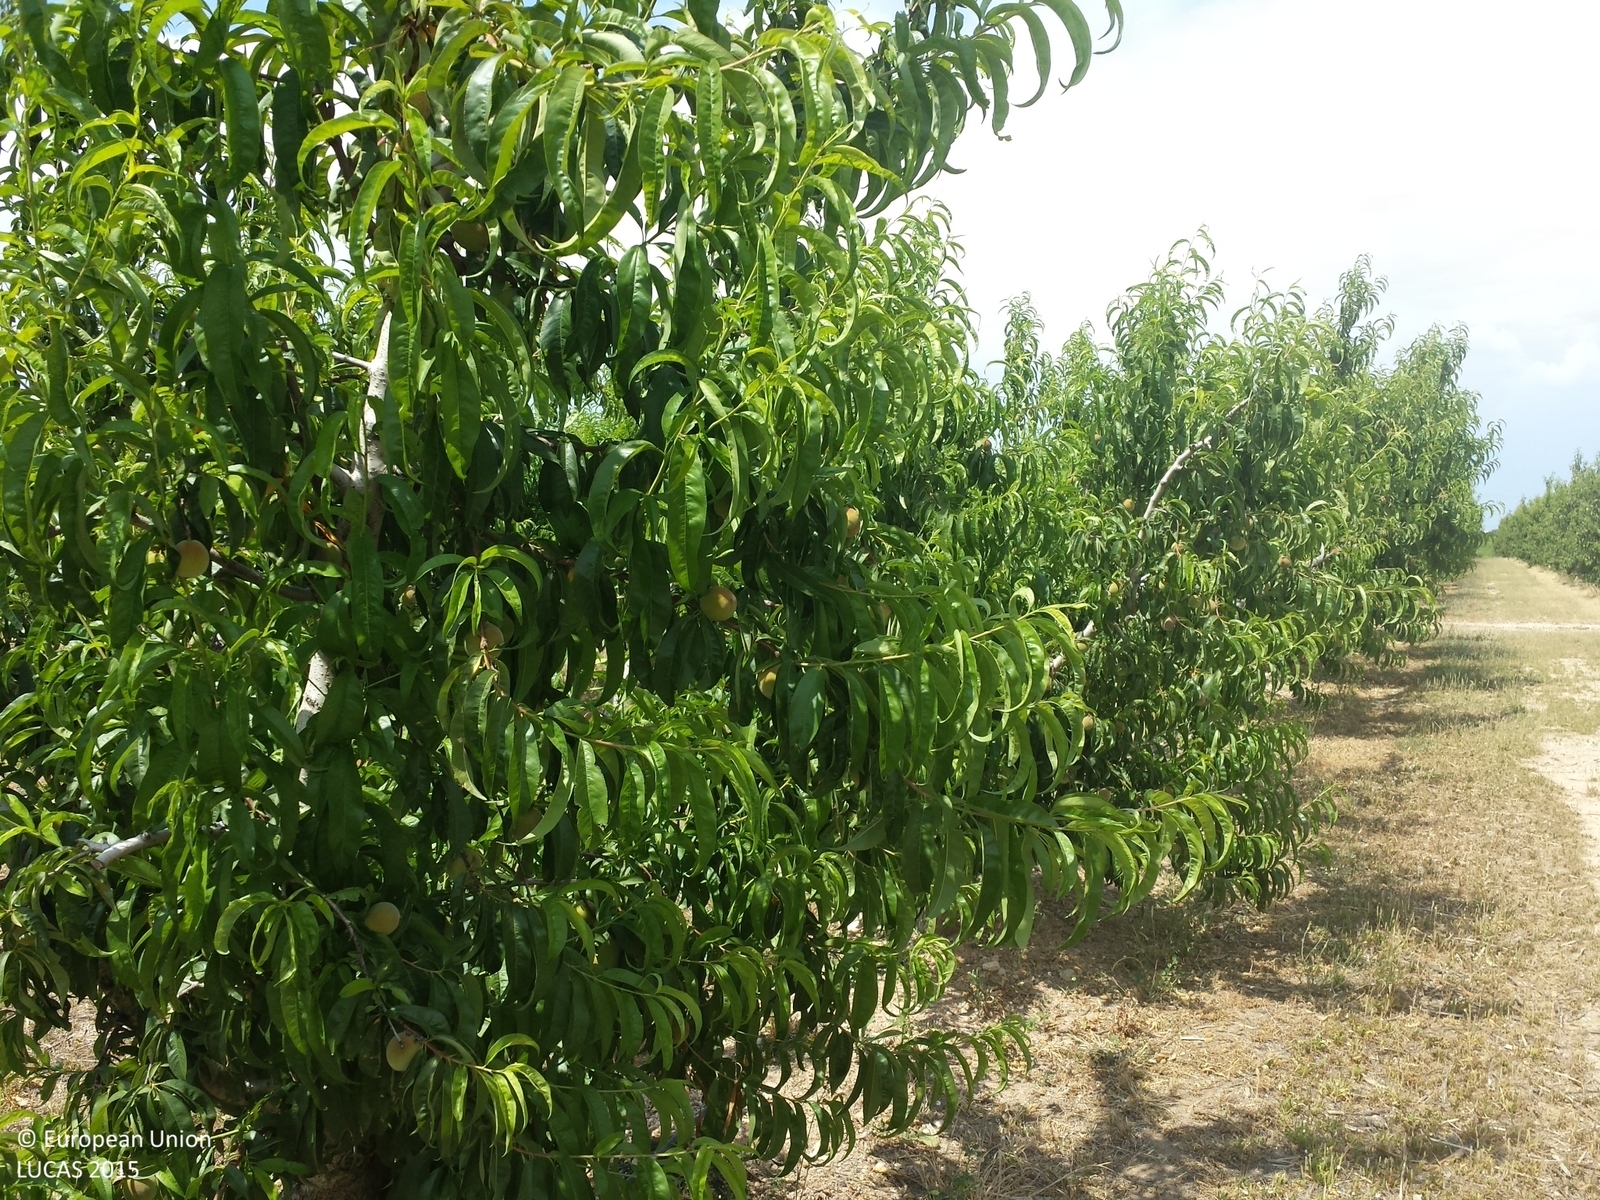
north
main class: Cropland
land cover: Other fruit trees and berries
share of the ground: 25 - 50 %
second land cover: Spontaneously vegetated surfaces
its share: 50 - 75 %
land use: Agriculture (excluding fallow land and kitchen gardens)
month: June
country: ES
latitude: 41.5392
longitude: 0.5544
